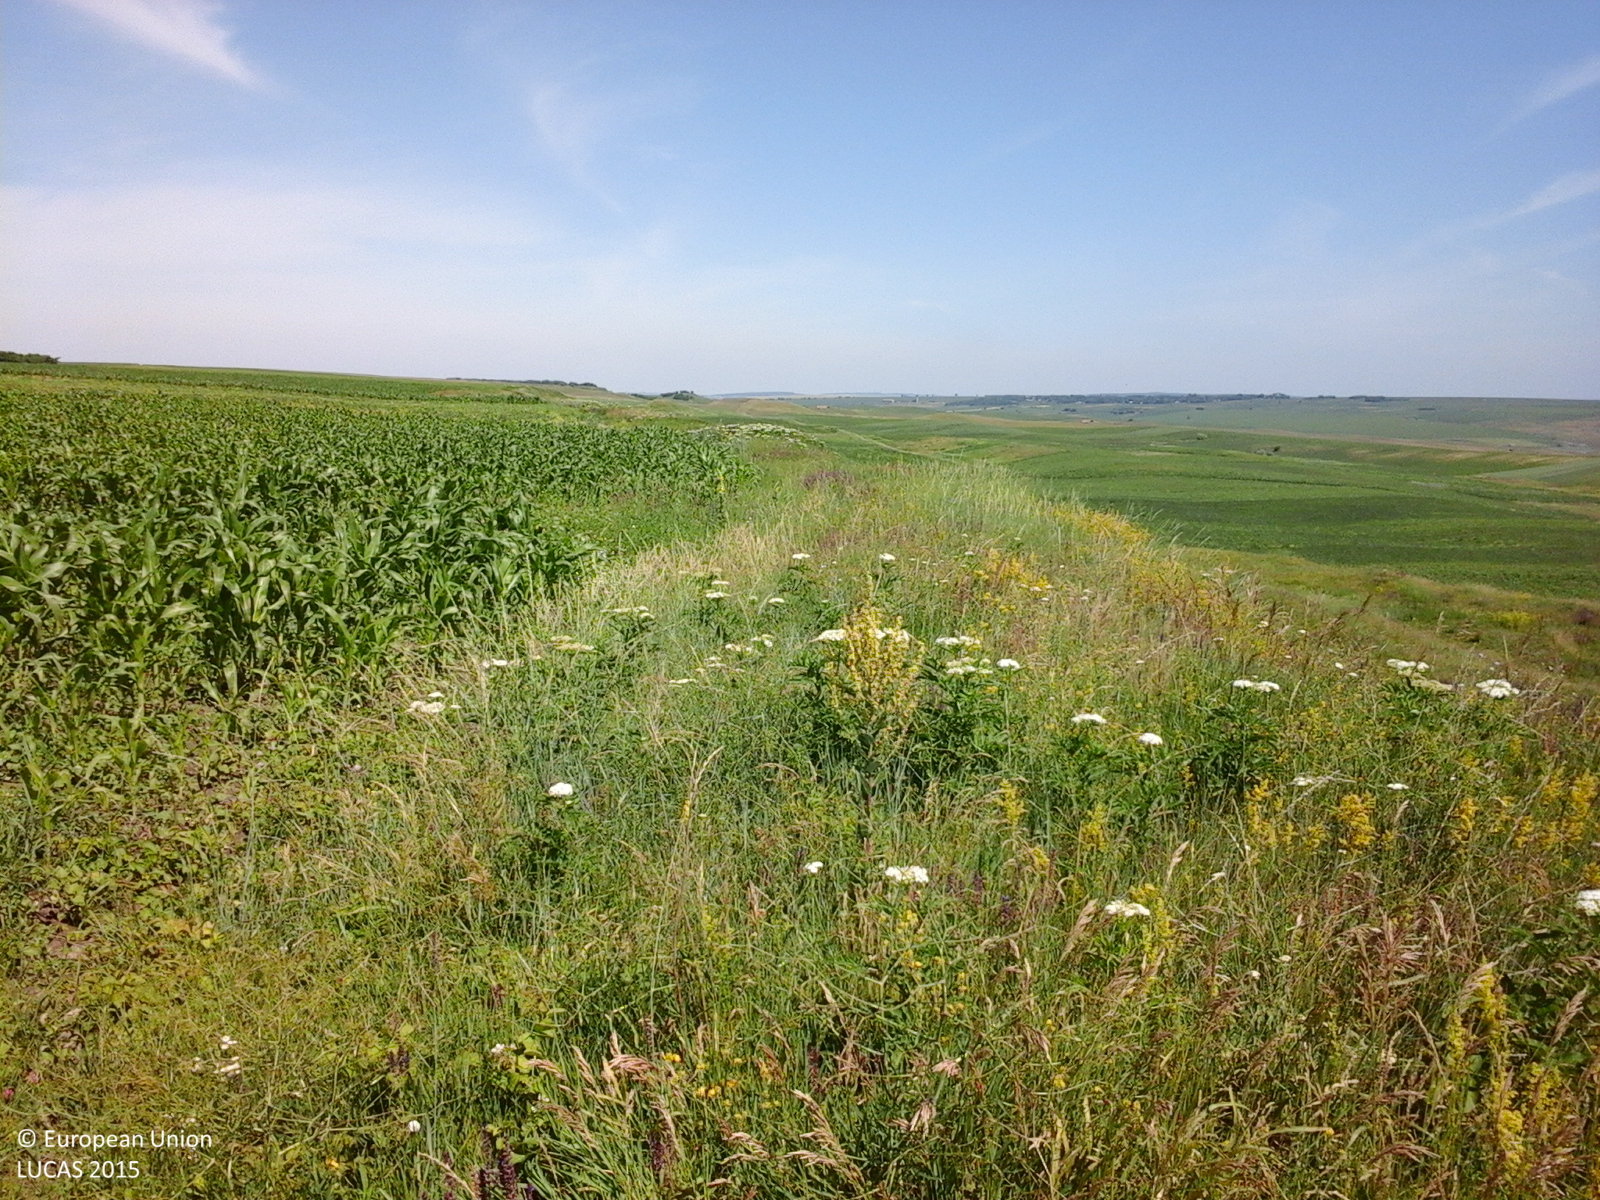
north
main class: Grassland
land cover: Grassland without tree/shrub cover
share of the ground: > 75 %
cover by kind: herbaceous plants 100 %
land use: Agriculture (excluding fallow land and kitchen gardens)
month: June
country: RO
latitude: 48.1435
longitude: 26.8627
